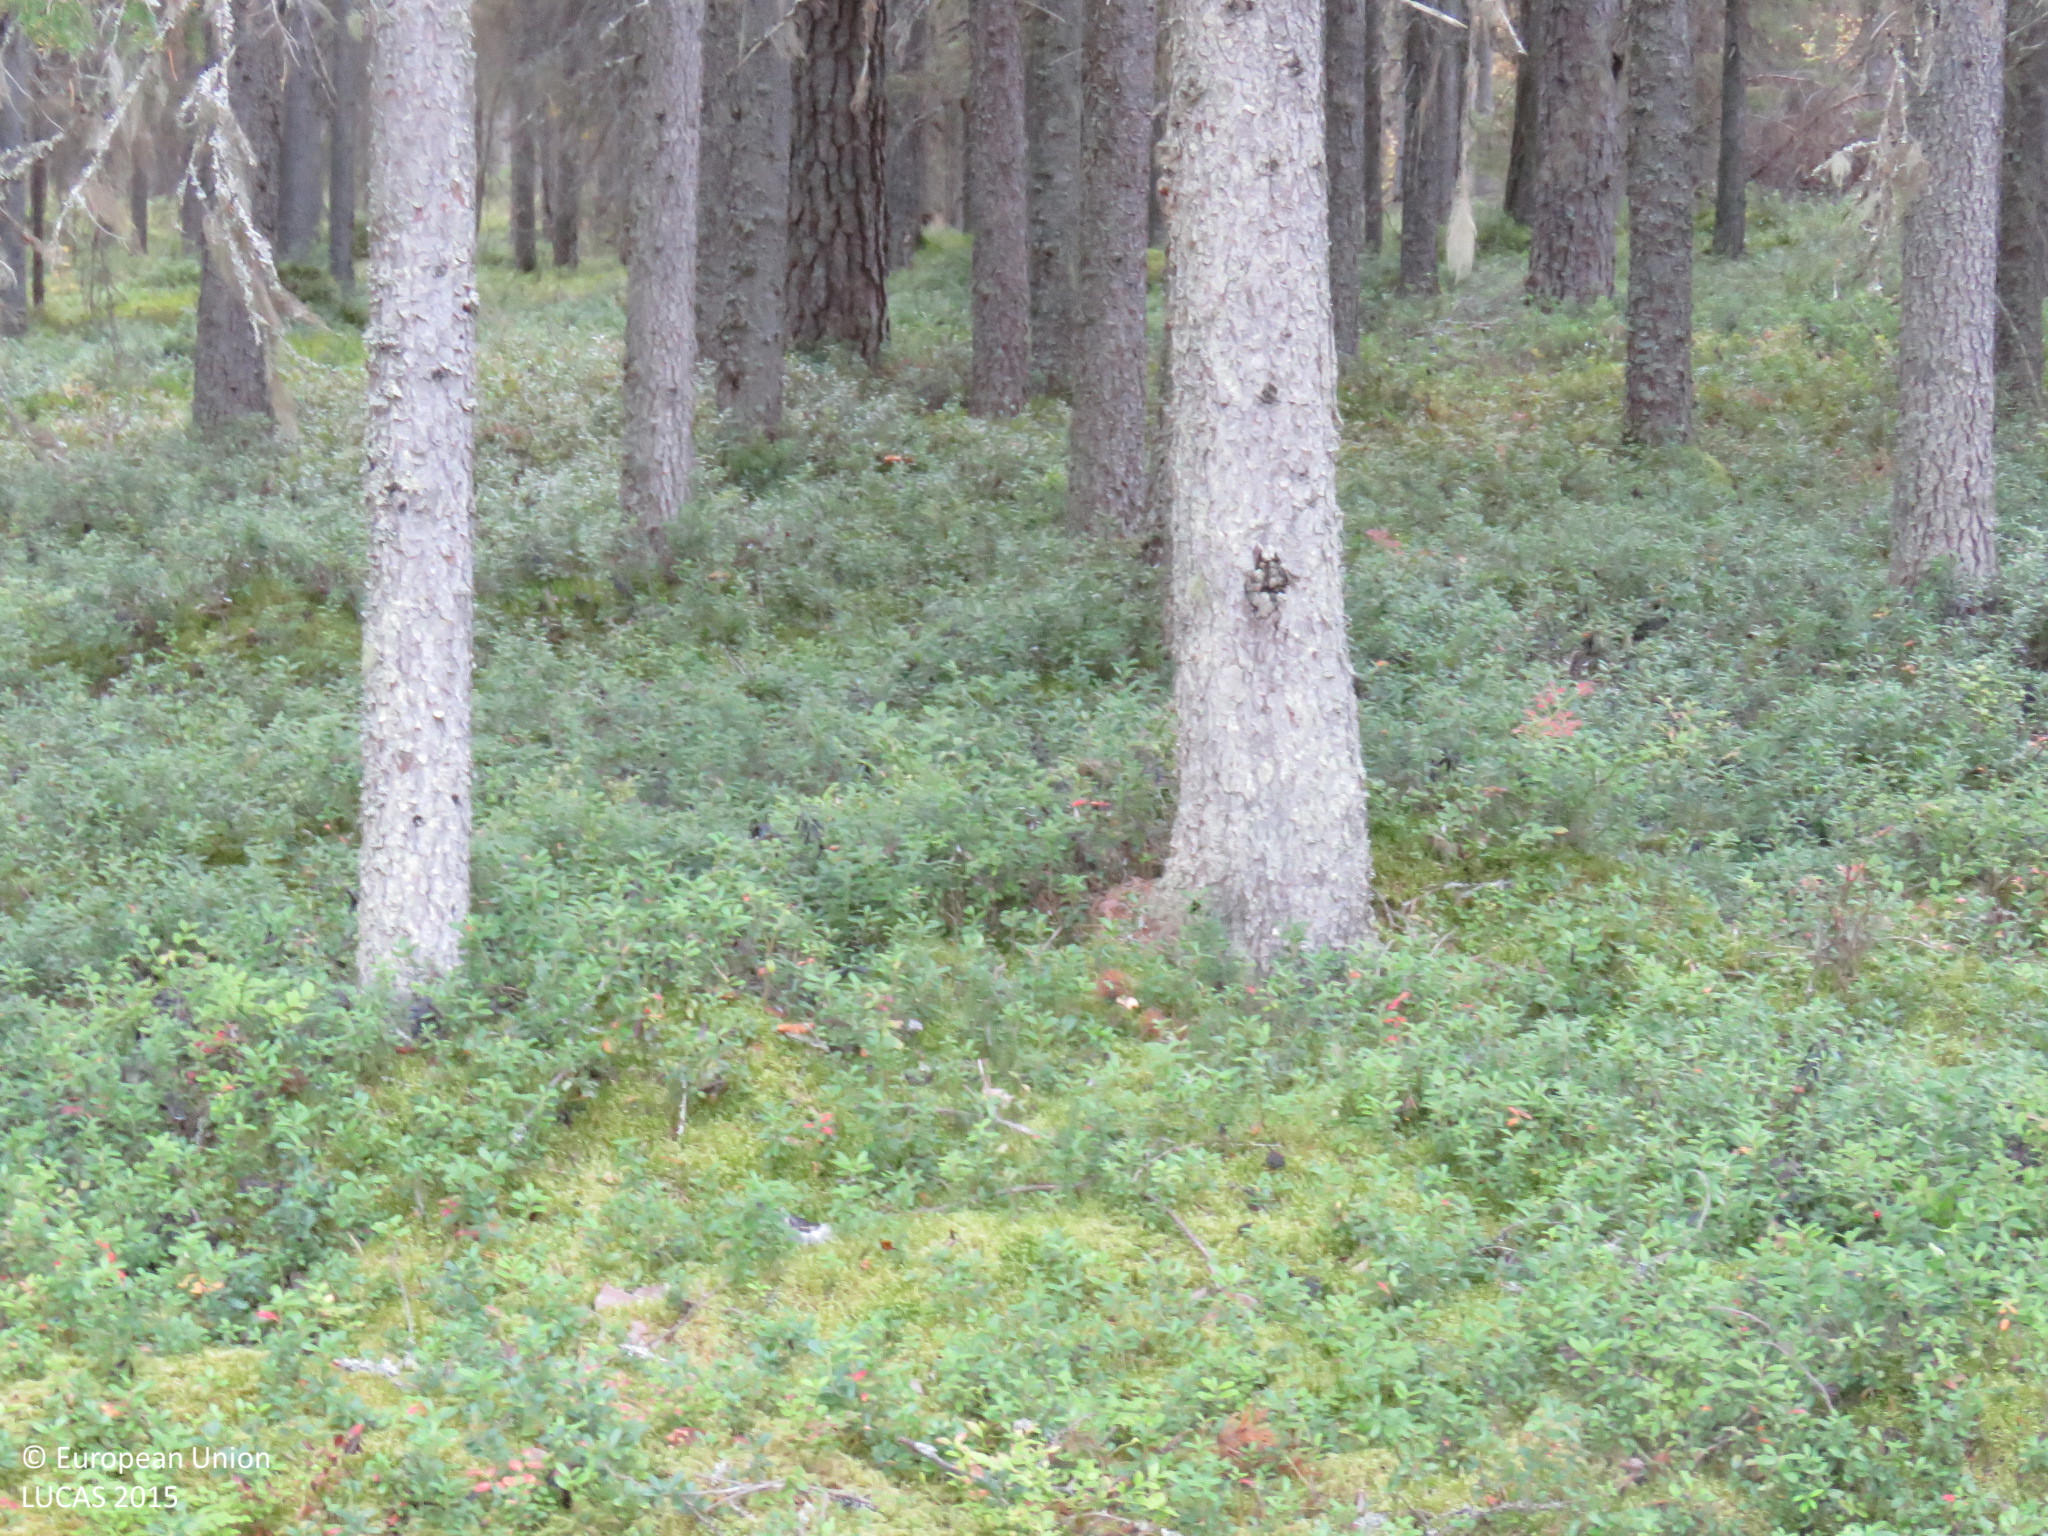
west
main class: Woodland
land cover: Other coniferous woodland
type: boreal forest
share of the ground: > 75 %
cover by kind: coniferous forest trees 70 %, shrubs 15 %, broadleaved forest trees 10 %, lichens and mosses 5 %
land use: Forestry
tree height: > 5 m
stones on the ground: < 10 %
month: September
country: FI
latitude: 65.0389
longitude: 26.3940
